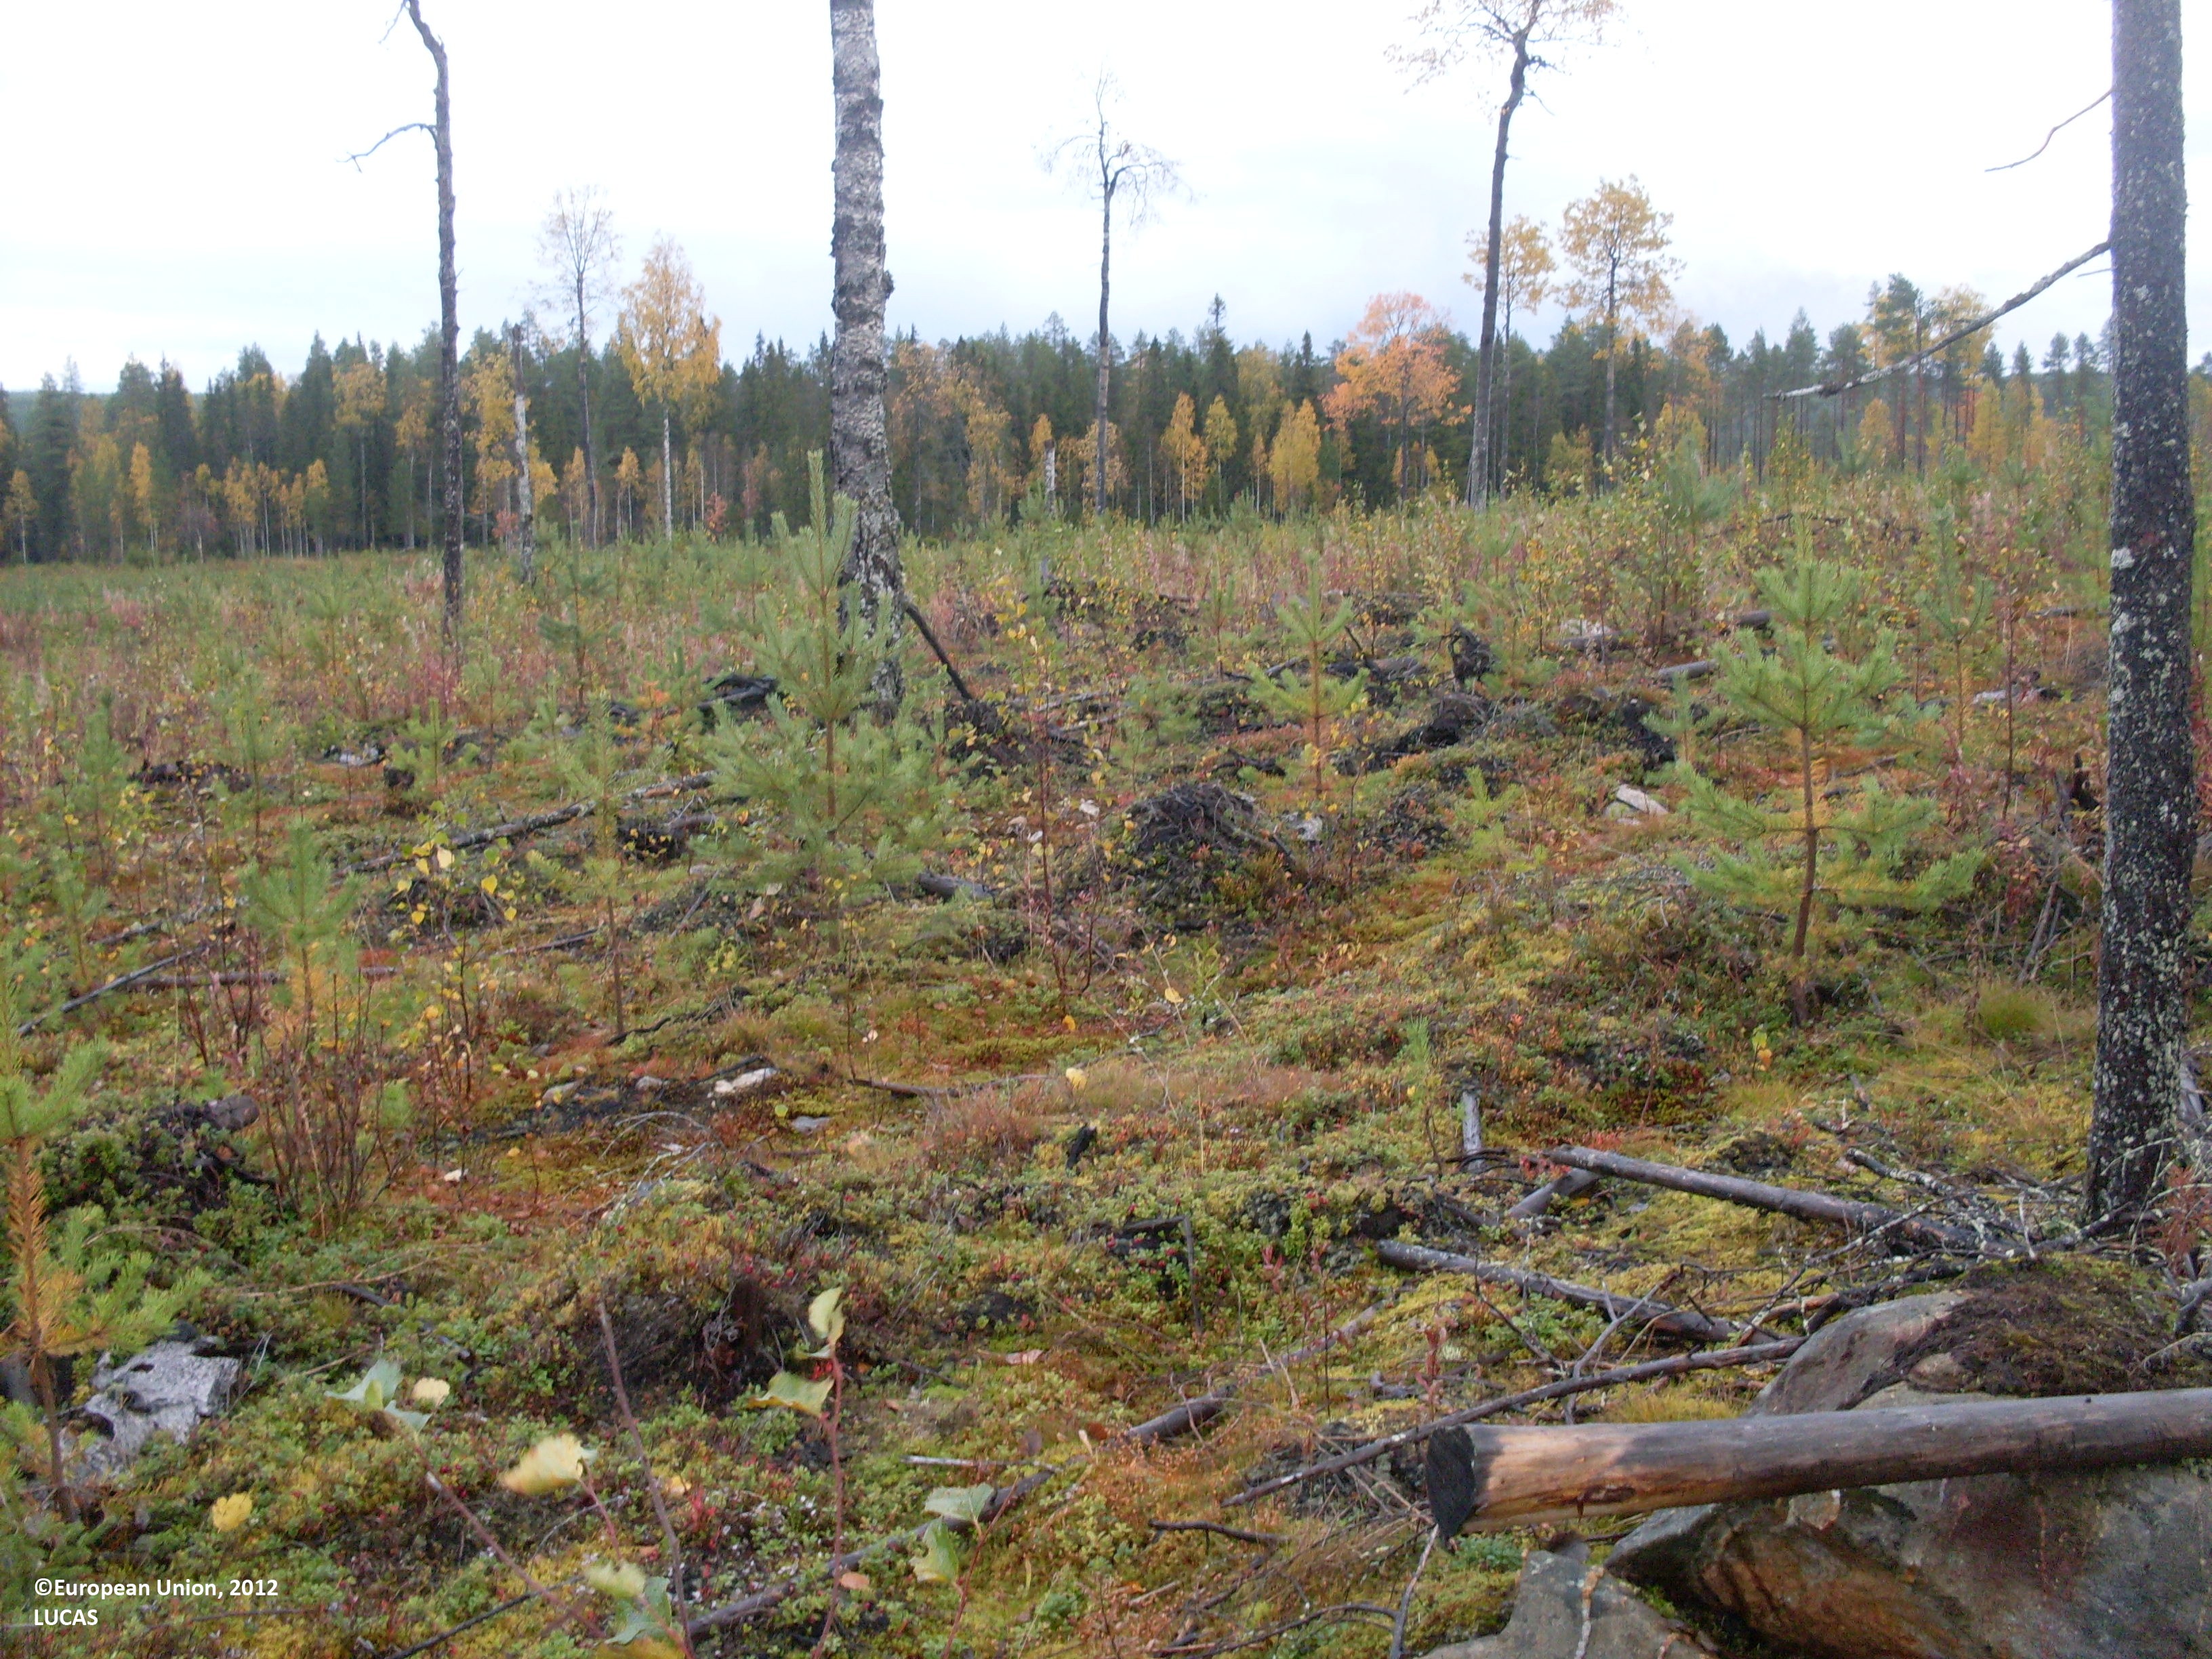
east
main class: Shrubland
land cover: Shrubland with sparse tree cover
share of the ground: 25 - 50 %
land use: Forestry
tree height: < 5 m
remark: Clear cut
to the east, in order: Shrubland with sparse tree cover
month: September
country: FI
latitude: 64.4866
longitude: 28.6813
